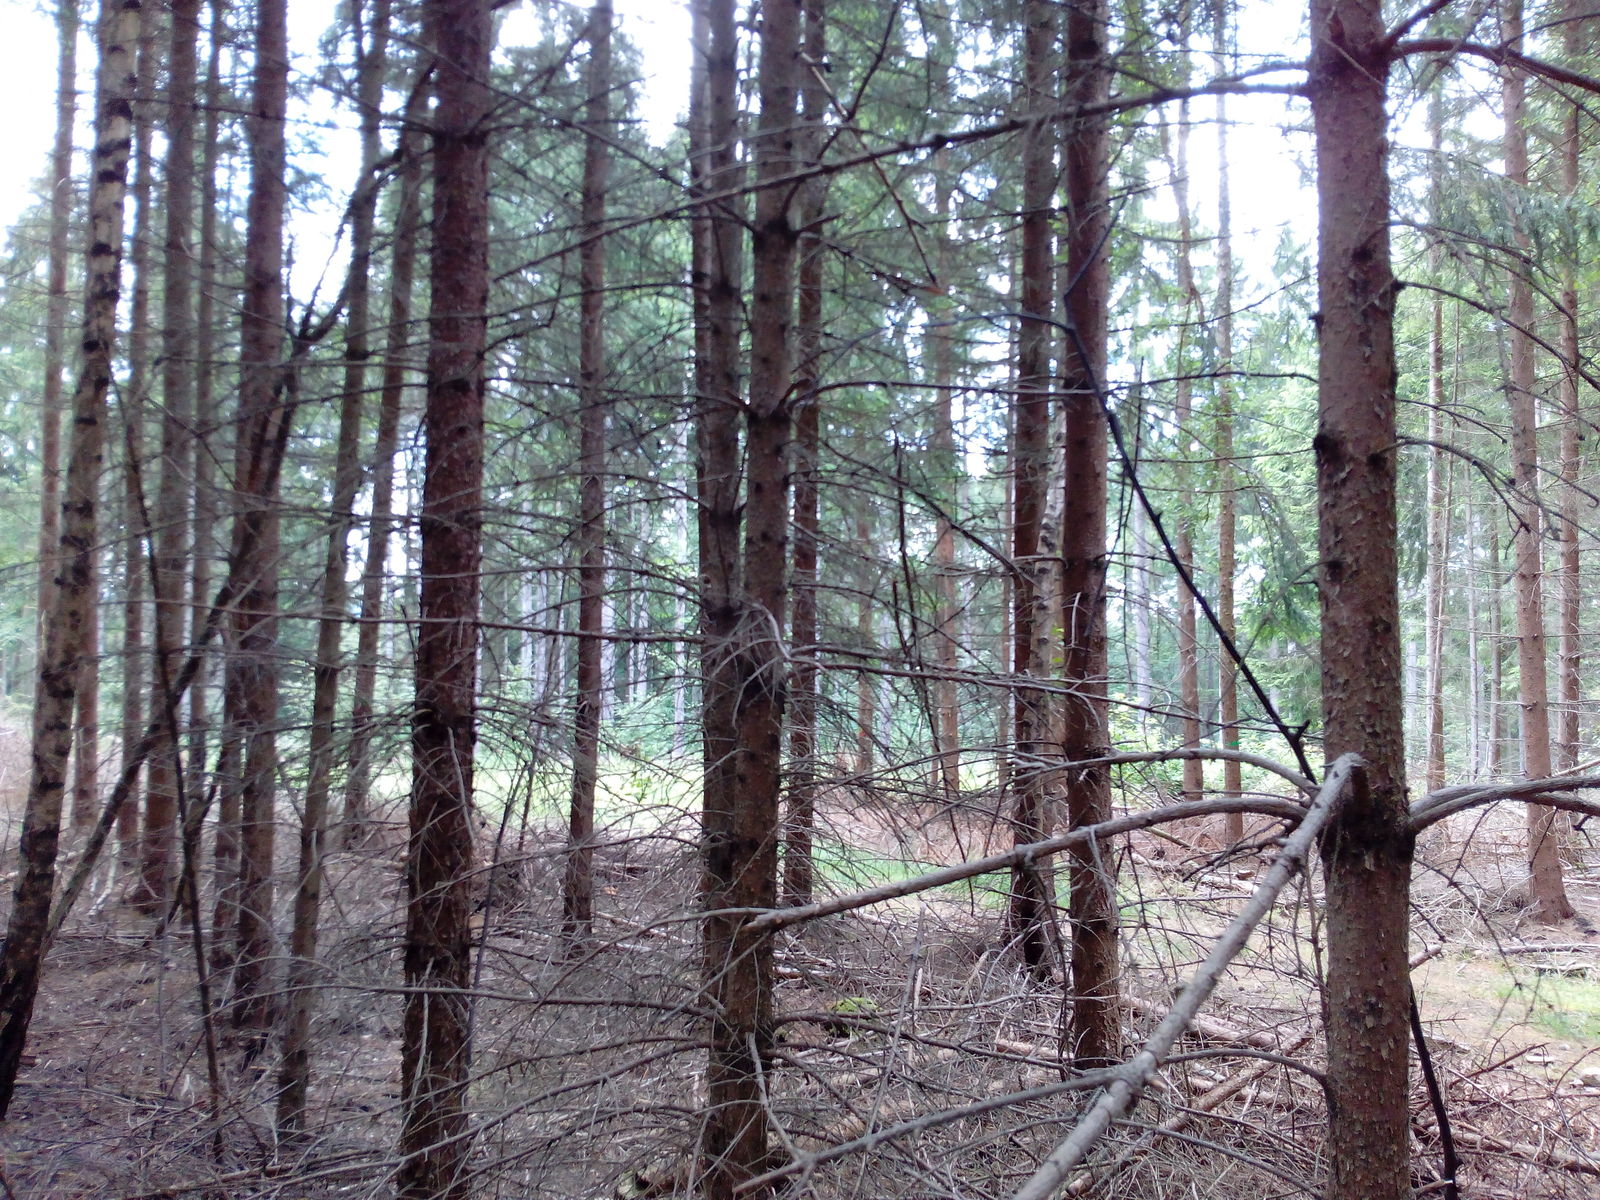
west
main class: Woodland
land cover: Spruce dominated coniferous woodland
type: hemiboreal forest and nemoral coniferous forest and mixed broadleaved-coniferous forest
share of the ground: > 75 %
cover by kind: coniferous forest trees 95 %, broadleaved forest trees 5 %
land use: Forestry
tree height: > 5 m
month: June
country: DE
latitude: 50.7566
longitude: 10.8361
